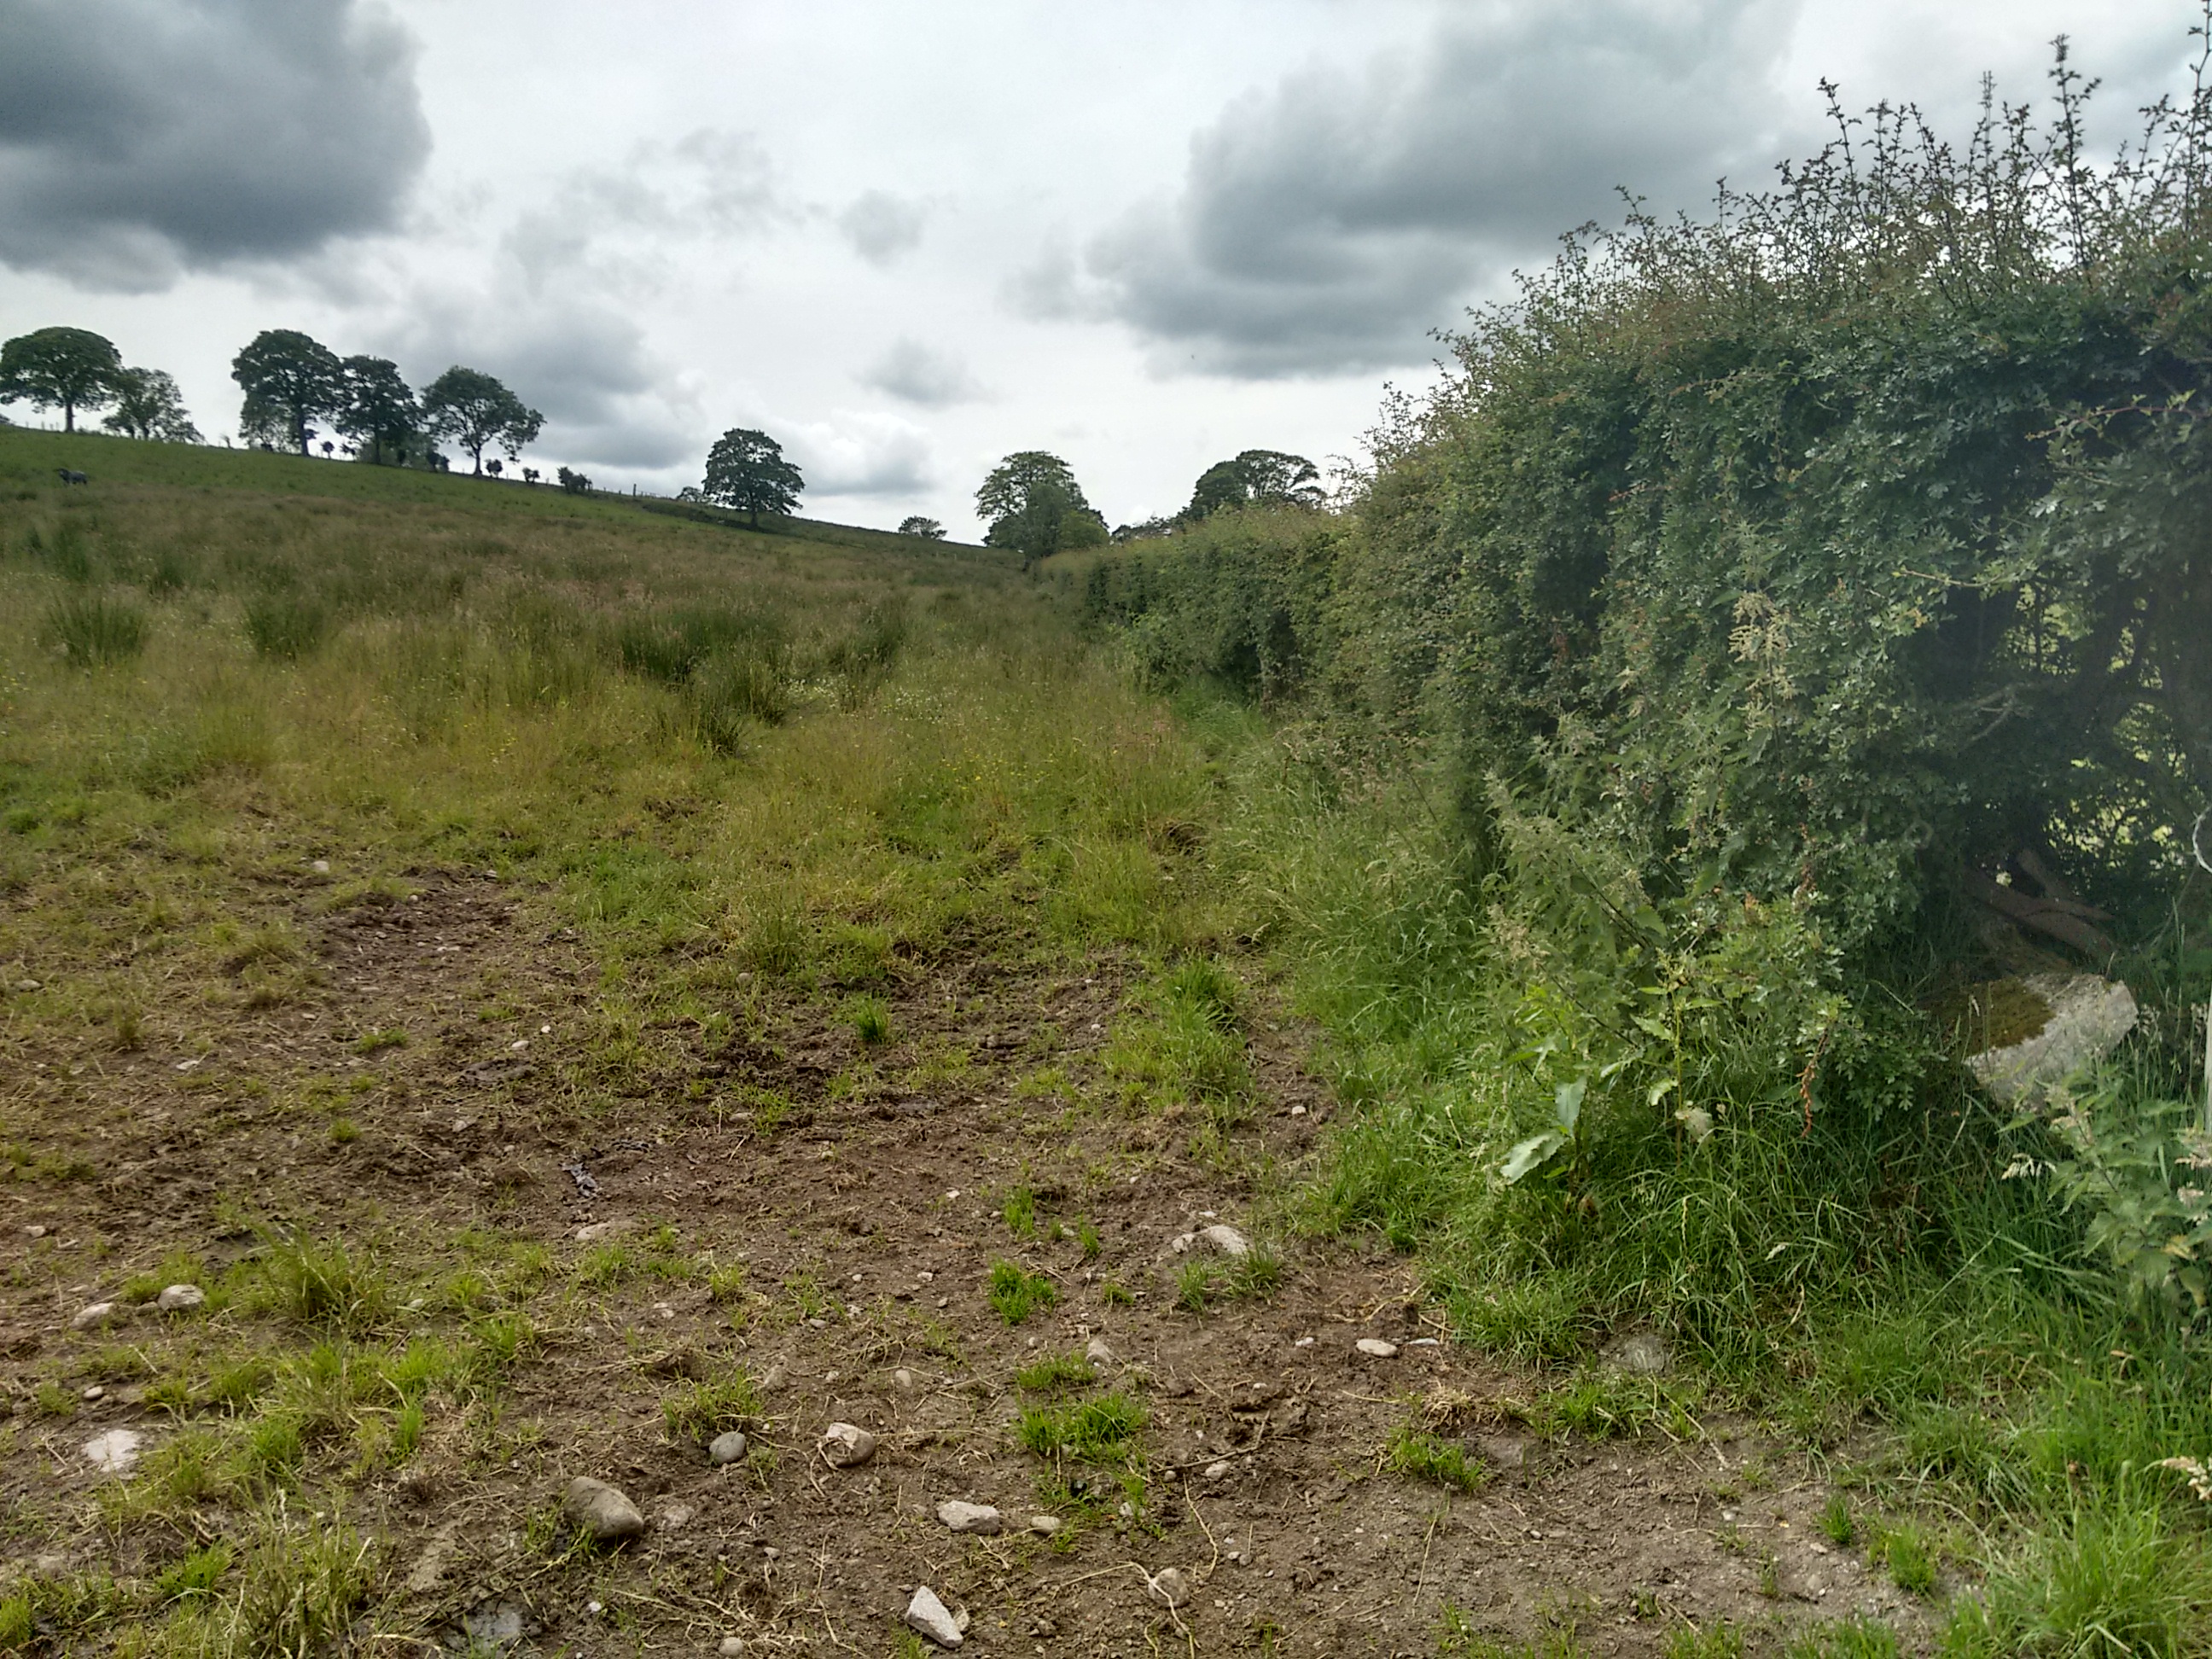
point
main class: Grassland
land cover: Grassland without tree/shrub cover
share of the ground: > 75 %
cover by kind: herbaceous plants 100 %
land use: Agriculture (excluding fallow land and kitchen gardens)
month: July
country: GB
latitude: 54.9034
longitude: -7.1902
